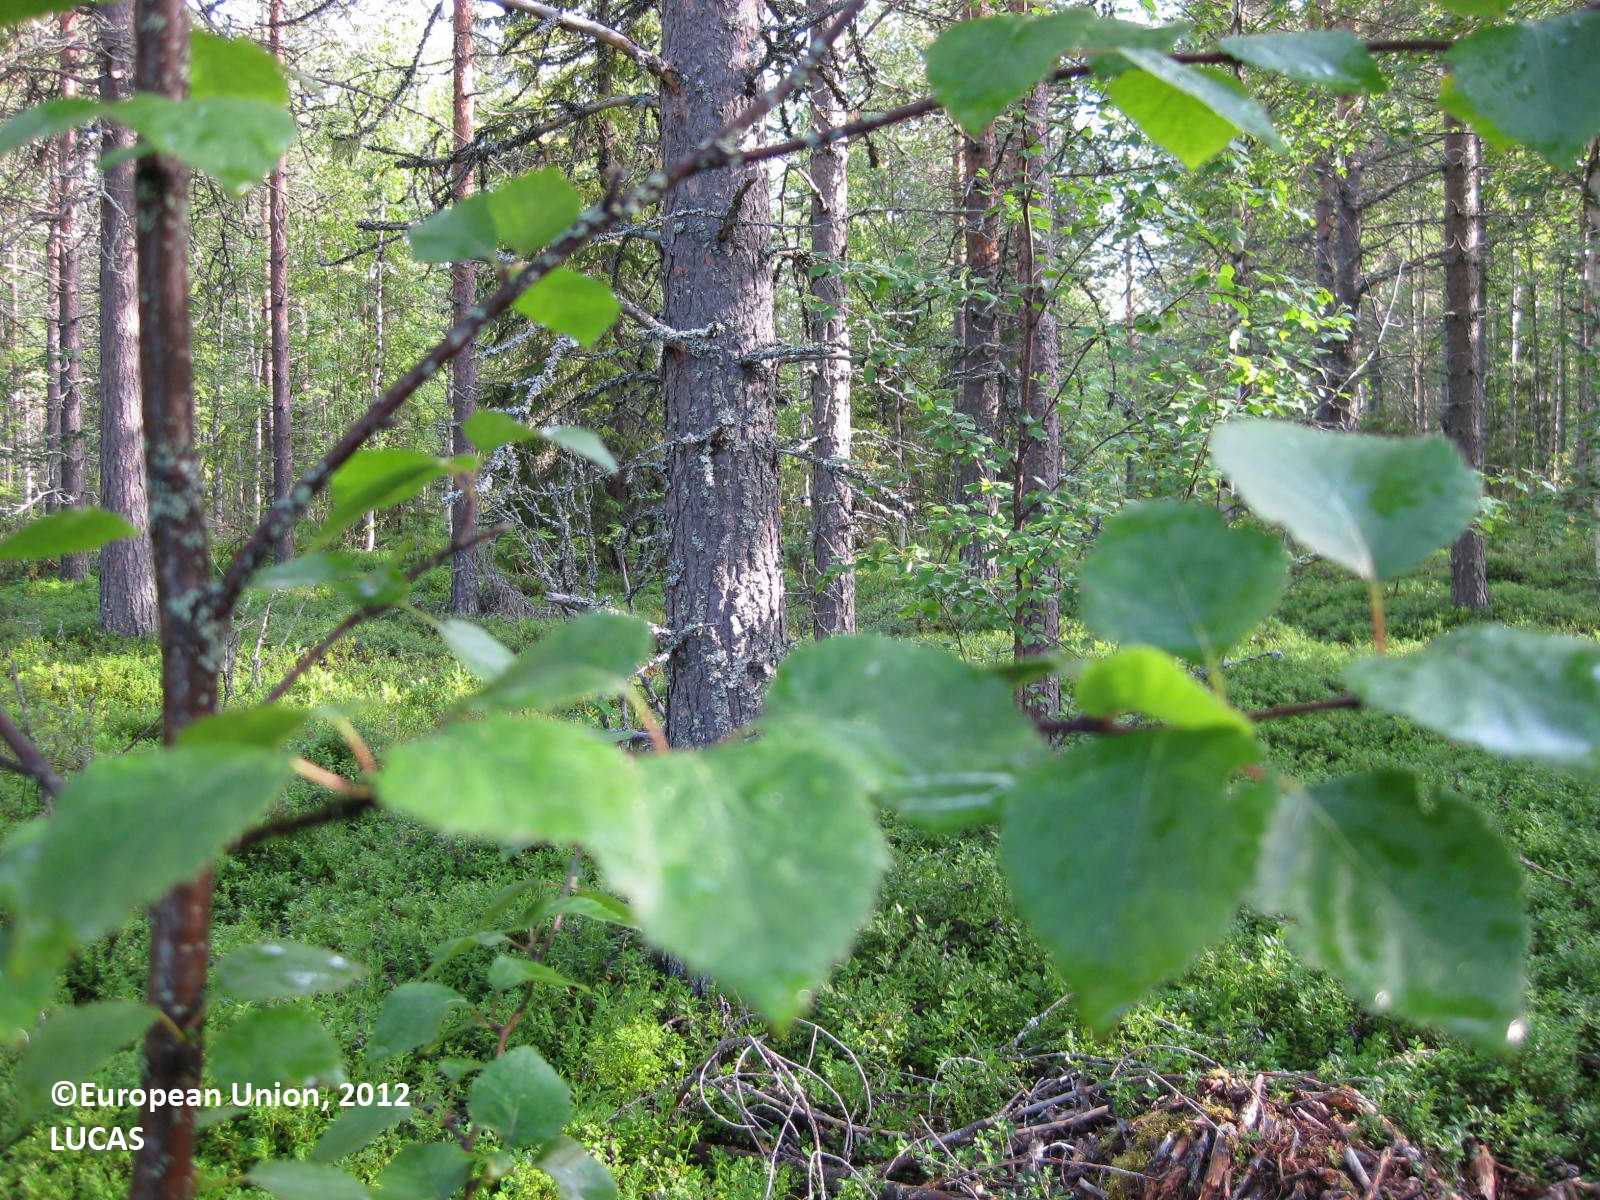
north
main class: Woodland
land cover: Pine dominated mixed woodland
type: boreal forest
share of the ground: 50 - 75 %
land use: Forestry
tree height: > 5 m
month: July
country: FI
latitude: 65.7333
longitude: 28.5870
